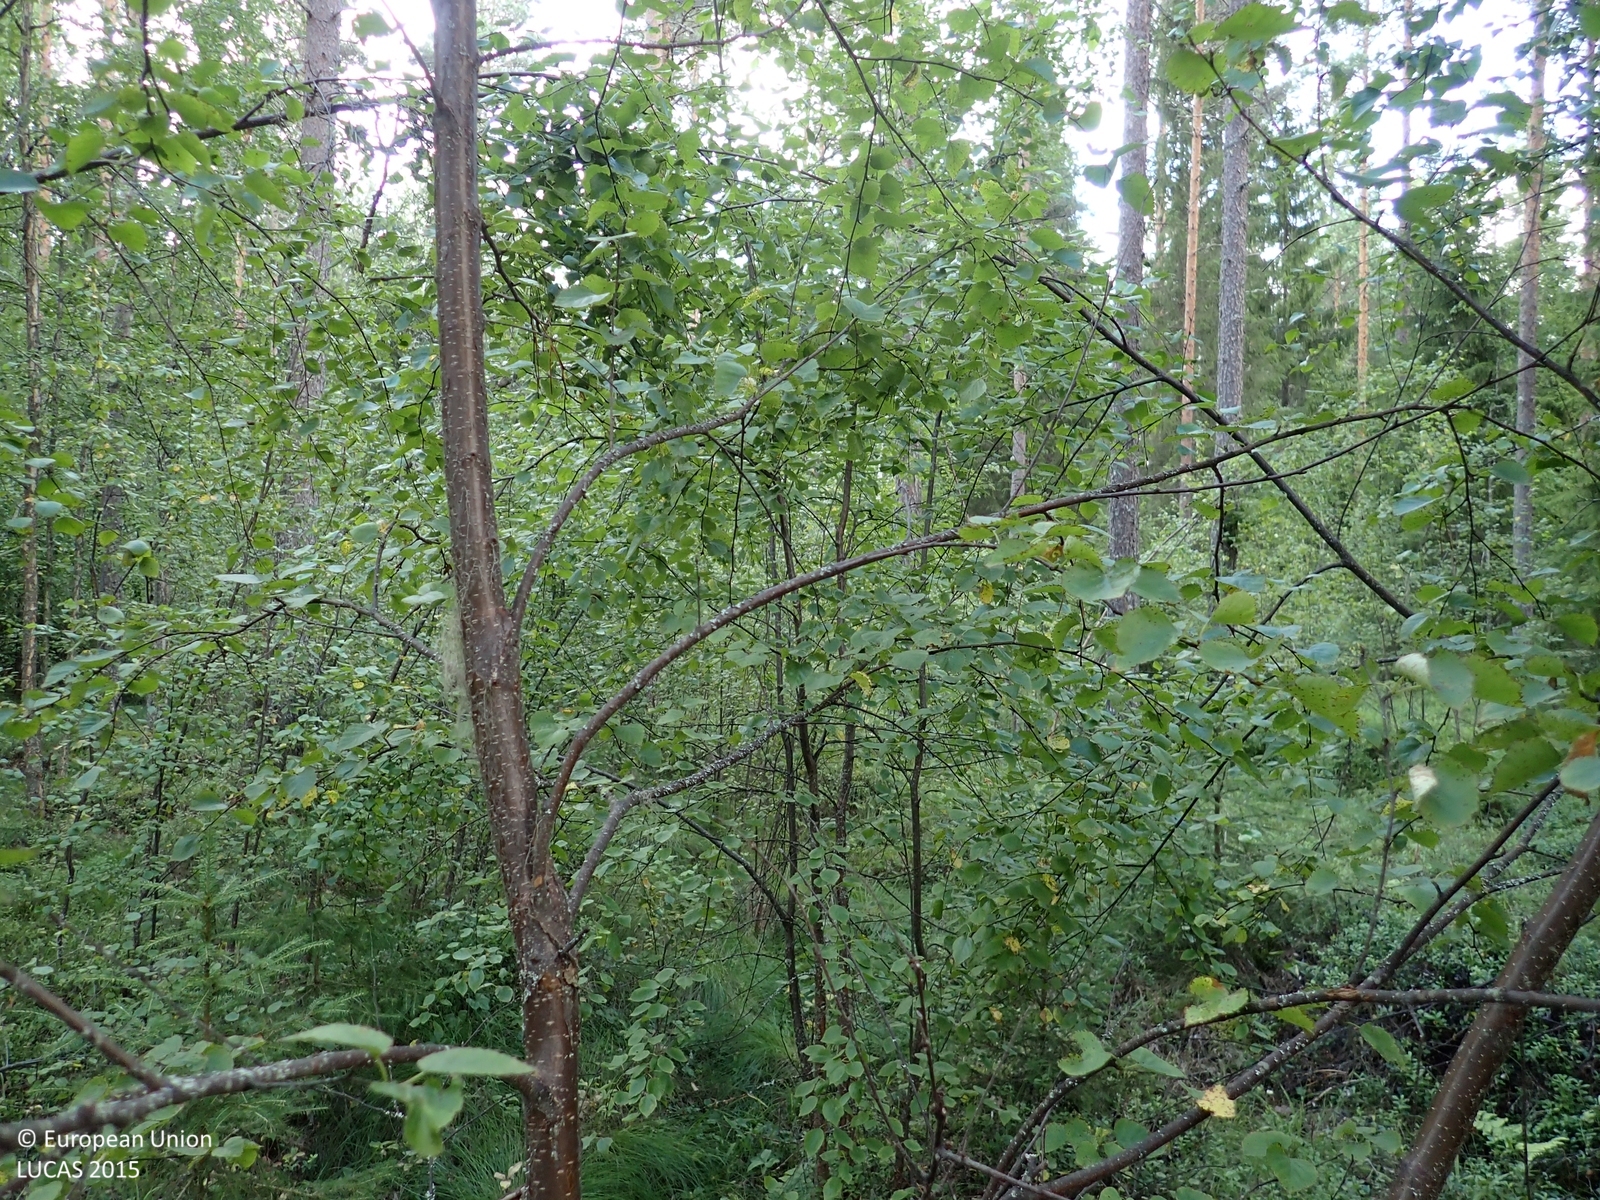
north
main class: Woodland
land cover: Pine dominated mixed woodland
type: boreal forest
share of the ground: > 75 %
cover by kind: coniferous forest trees 60 %, broadleaved forest trees 20 %, shrubs 15 %, herbaceous plants 5 %
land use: Forestry
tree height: > 5 m
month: August
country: FI
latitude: 62.7513
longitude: 22.0091
